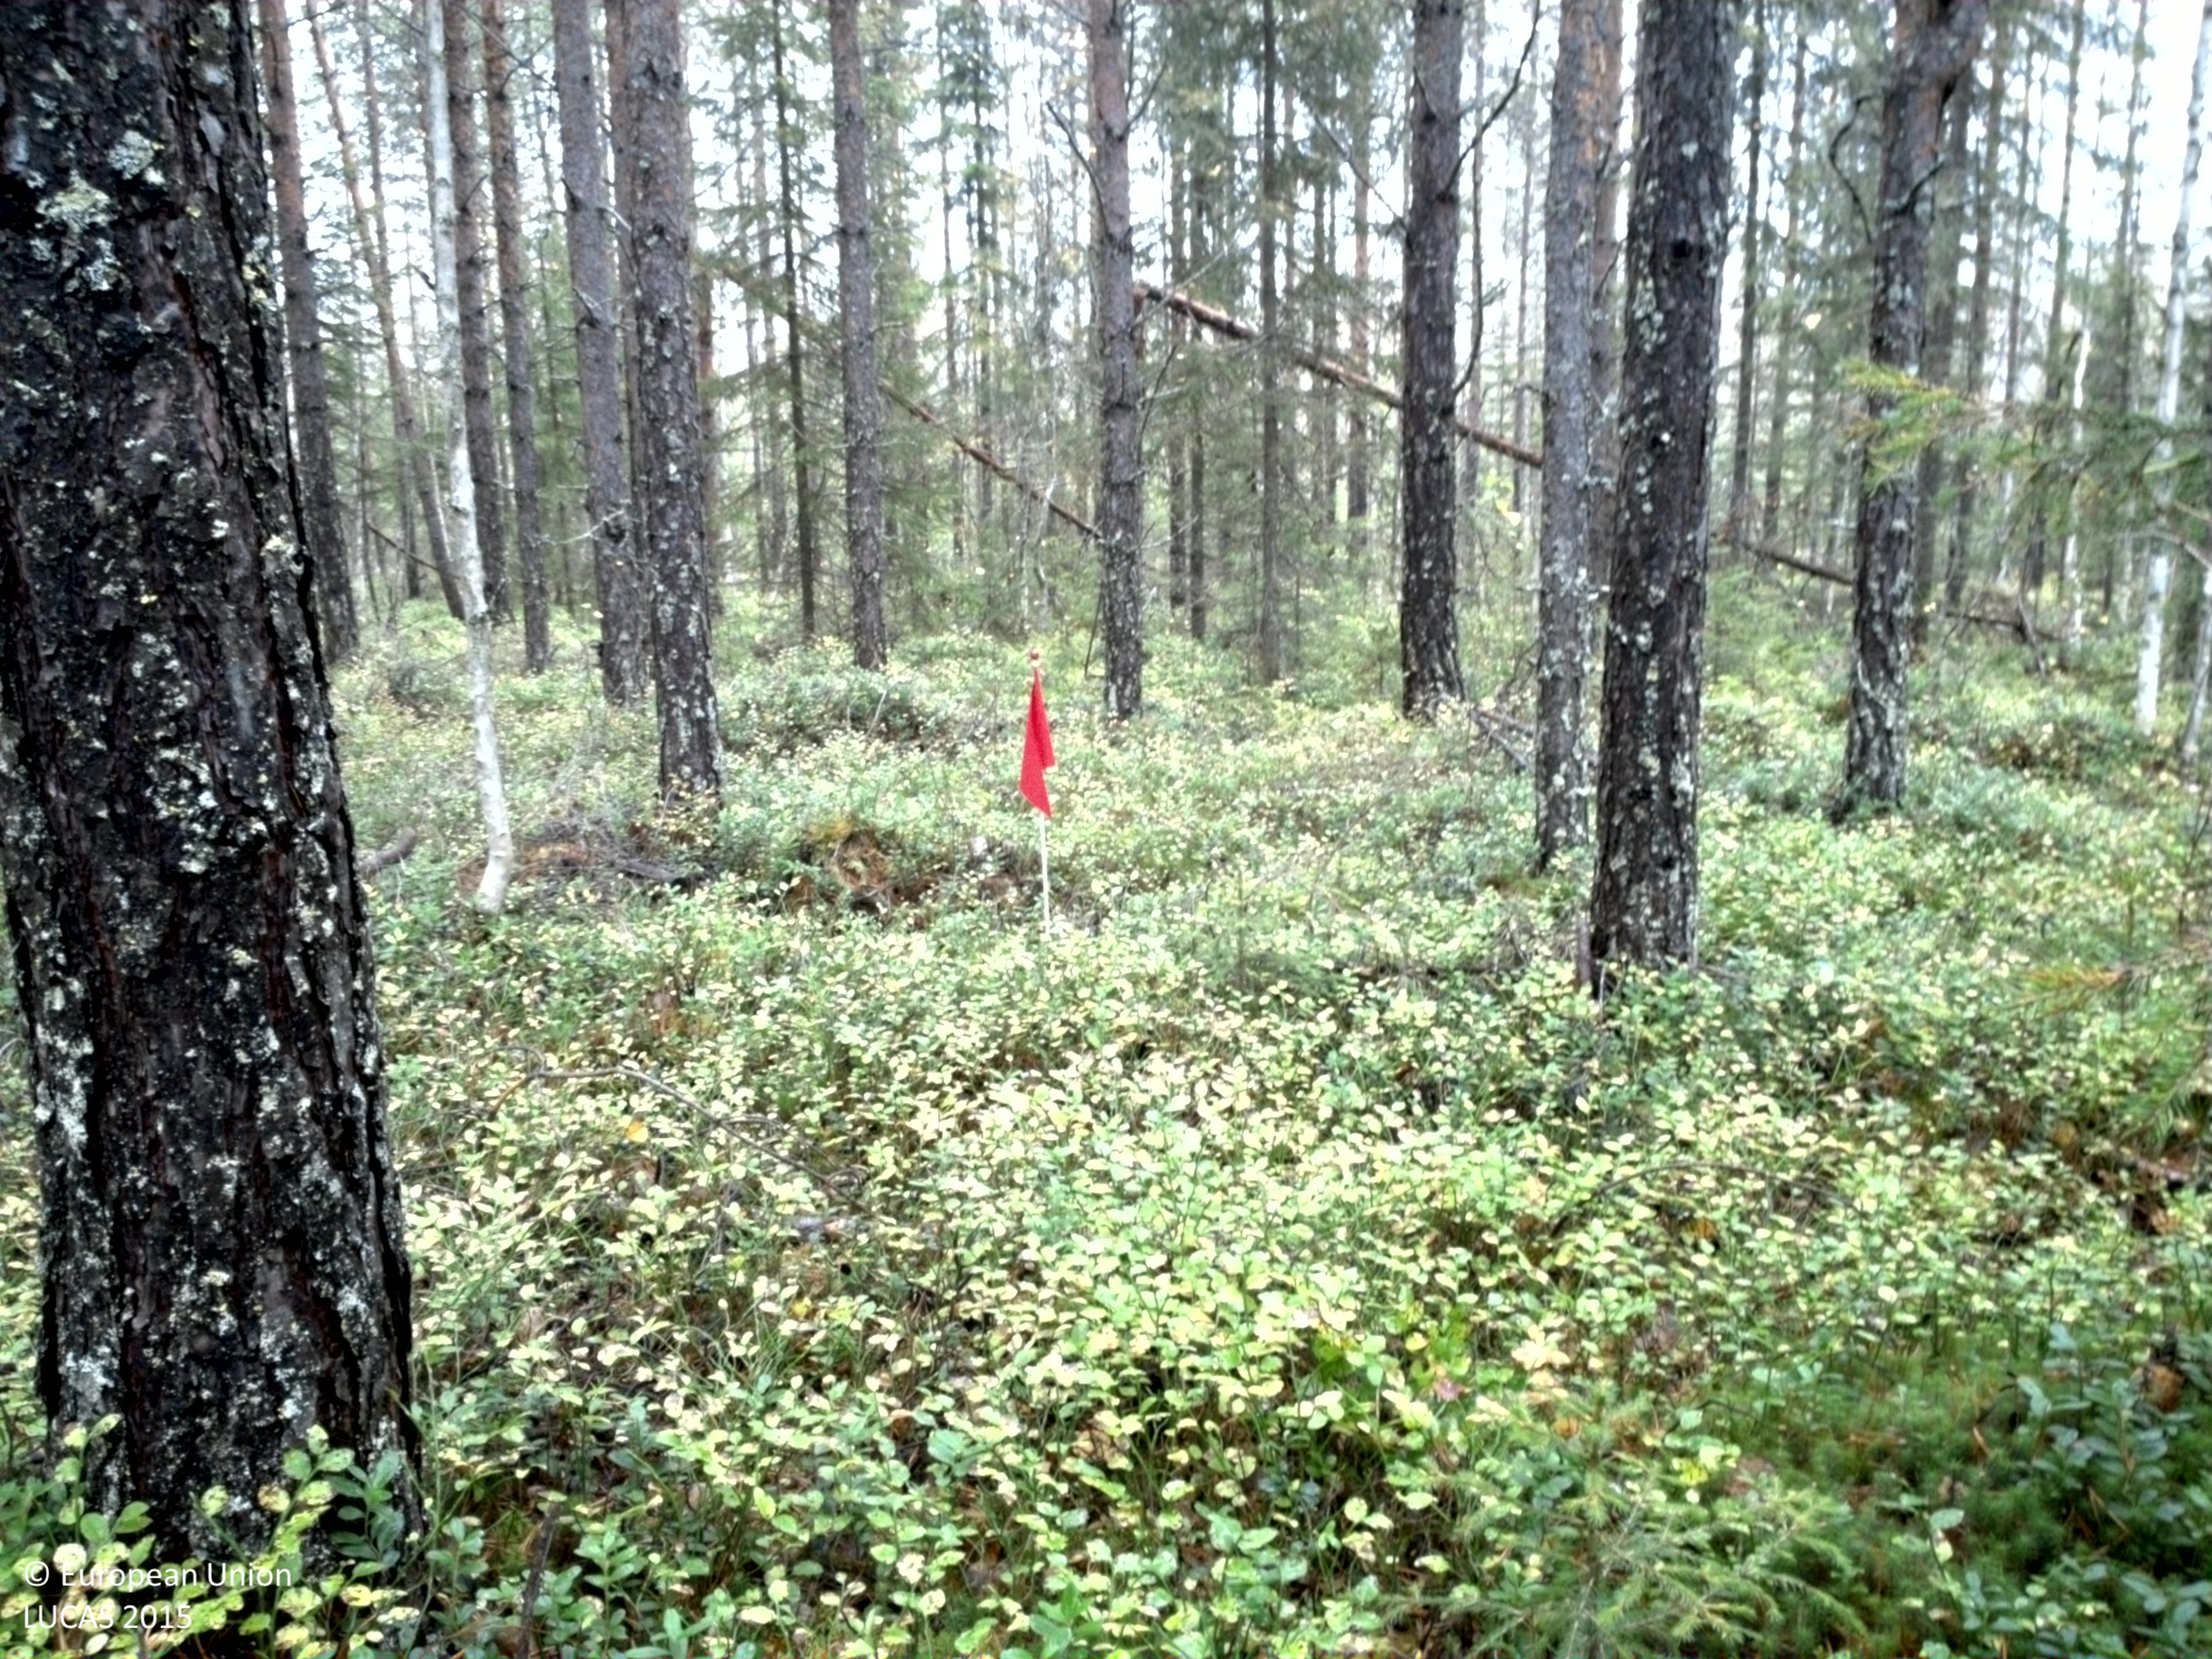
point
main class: Woodland
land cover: Pine dominated coniferous woodland
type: boreal forest
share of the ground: 25 - 50 %
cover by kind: shrubs 60 %, coniferous forest trees 40 %
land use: Forestry
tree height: > 5 m
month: September
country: SE
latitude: 65.6926
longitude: 22.1046
